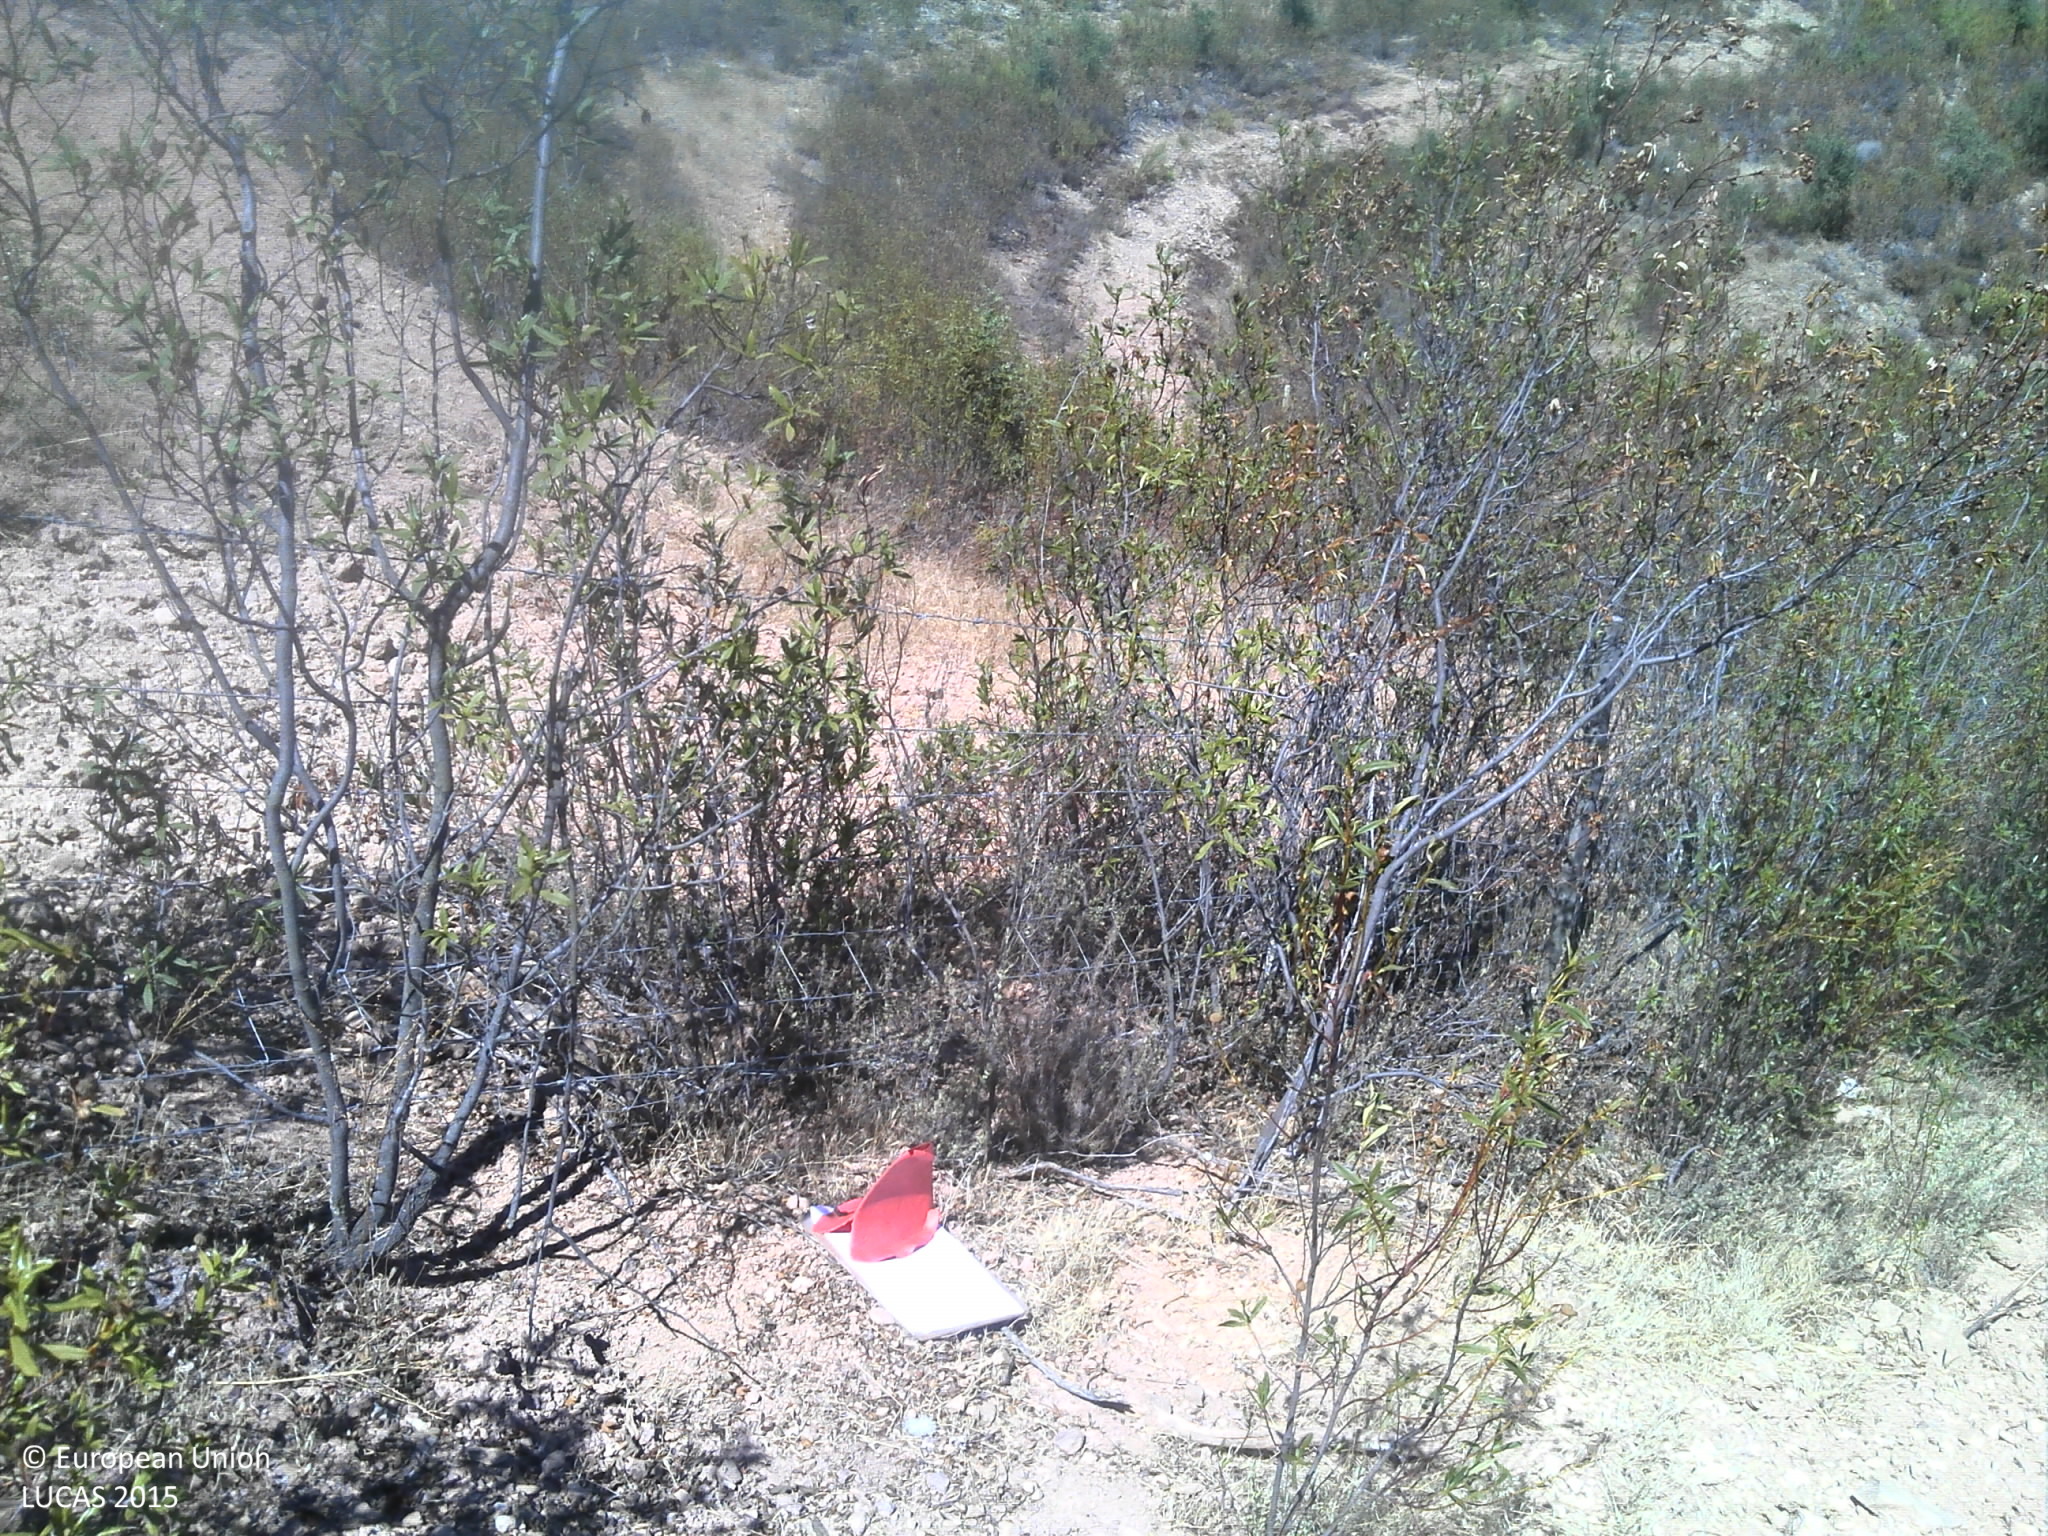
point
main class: Woodland
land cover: Broadleaved woodland
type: broadleaved evergreen forest
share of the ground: 10 - 25 %
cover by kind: unconsolidated bare surface 70 %, broadleaved forest trees 15 %, shrubs 15 %
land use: Forestry
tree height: < 5 m
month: August
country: PT
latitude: 37.4938
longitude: -8.2011
